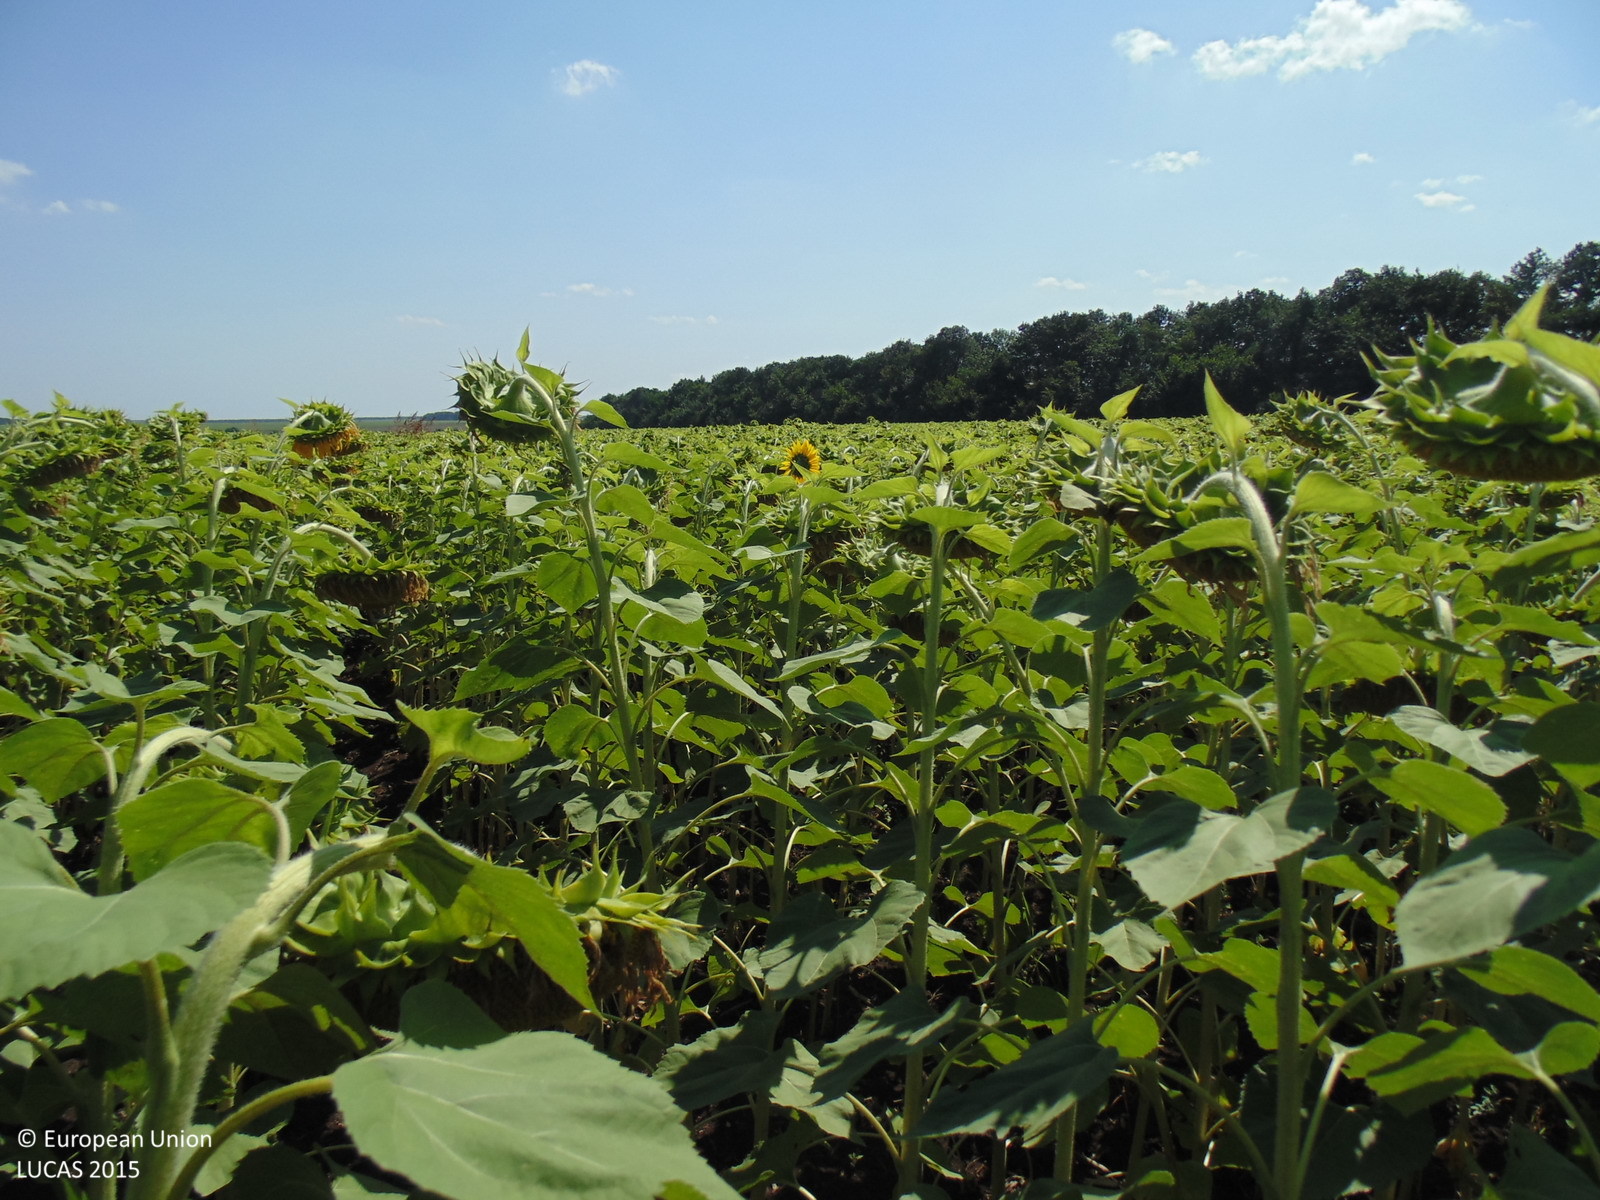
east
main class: Cropland
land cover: Sunflower
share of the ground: > 75 %
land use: Agriculture (excluding fallow land and kitchen gardens)
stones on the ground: < 10 %
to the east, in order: Sunflower; Grass margins; Broadleaved woodland
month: August
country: BG
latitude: 43.5524
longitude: 28.1103
